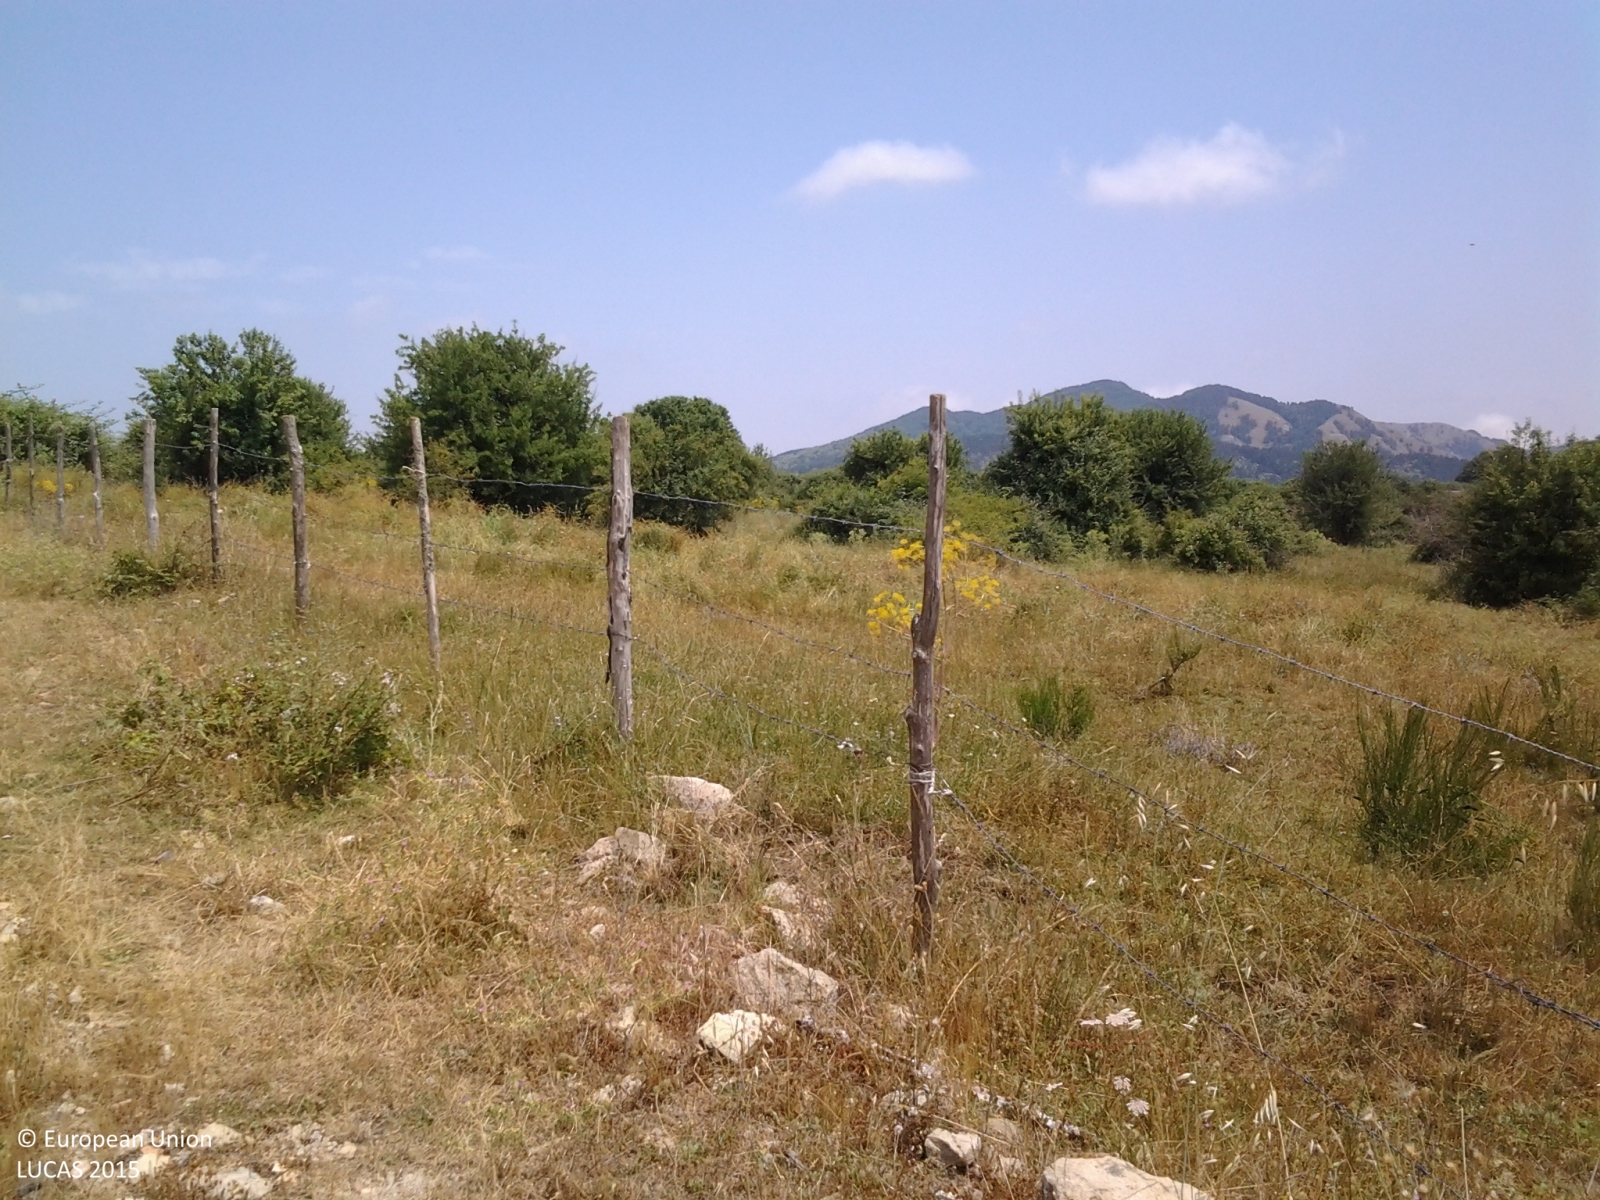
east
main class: Shrubland
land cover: Shrubland with sparse tree cover
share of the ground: > 75 %
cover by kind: shrubs 80 %, unconsolidated bare surface 10 %, broadleaved forest trees 5 %, herbaceous plants 5 %
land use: Agriculture (excluding fallow land and kitchen gardens)
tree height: < 5 m
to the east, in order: Shrubland with sparse tree cover; Grassland with sparse tree/shrub cover; Tracks; Single bushes/trees; Fences; Spontaneously vegetated surfaces; Ditches and canals; Spontaneously vegetated surfaces
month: July
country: IT
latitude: 37.9668
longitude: 14.8958
